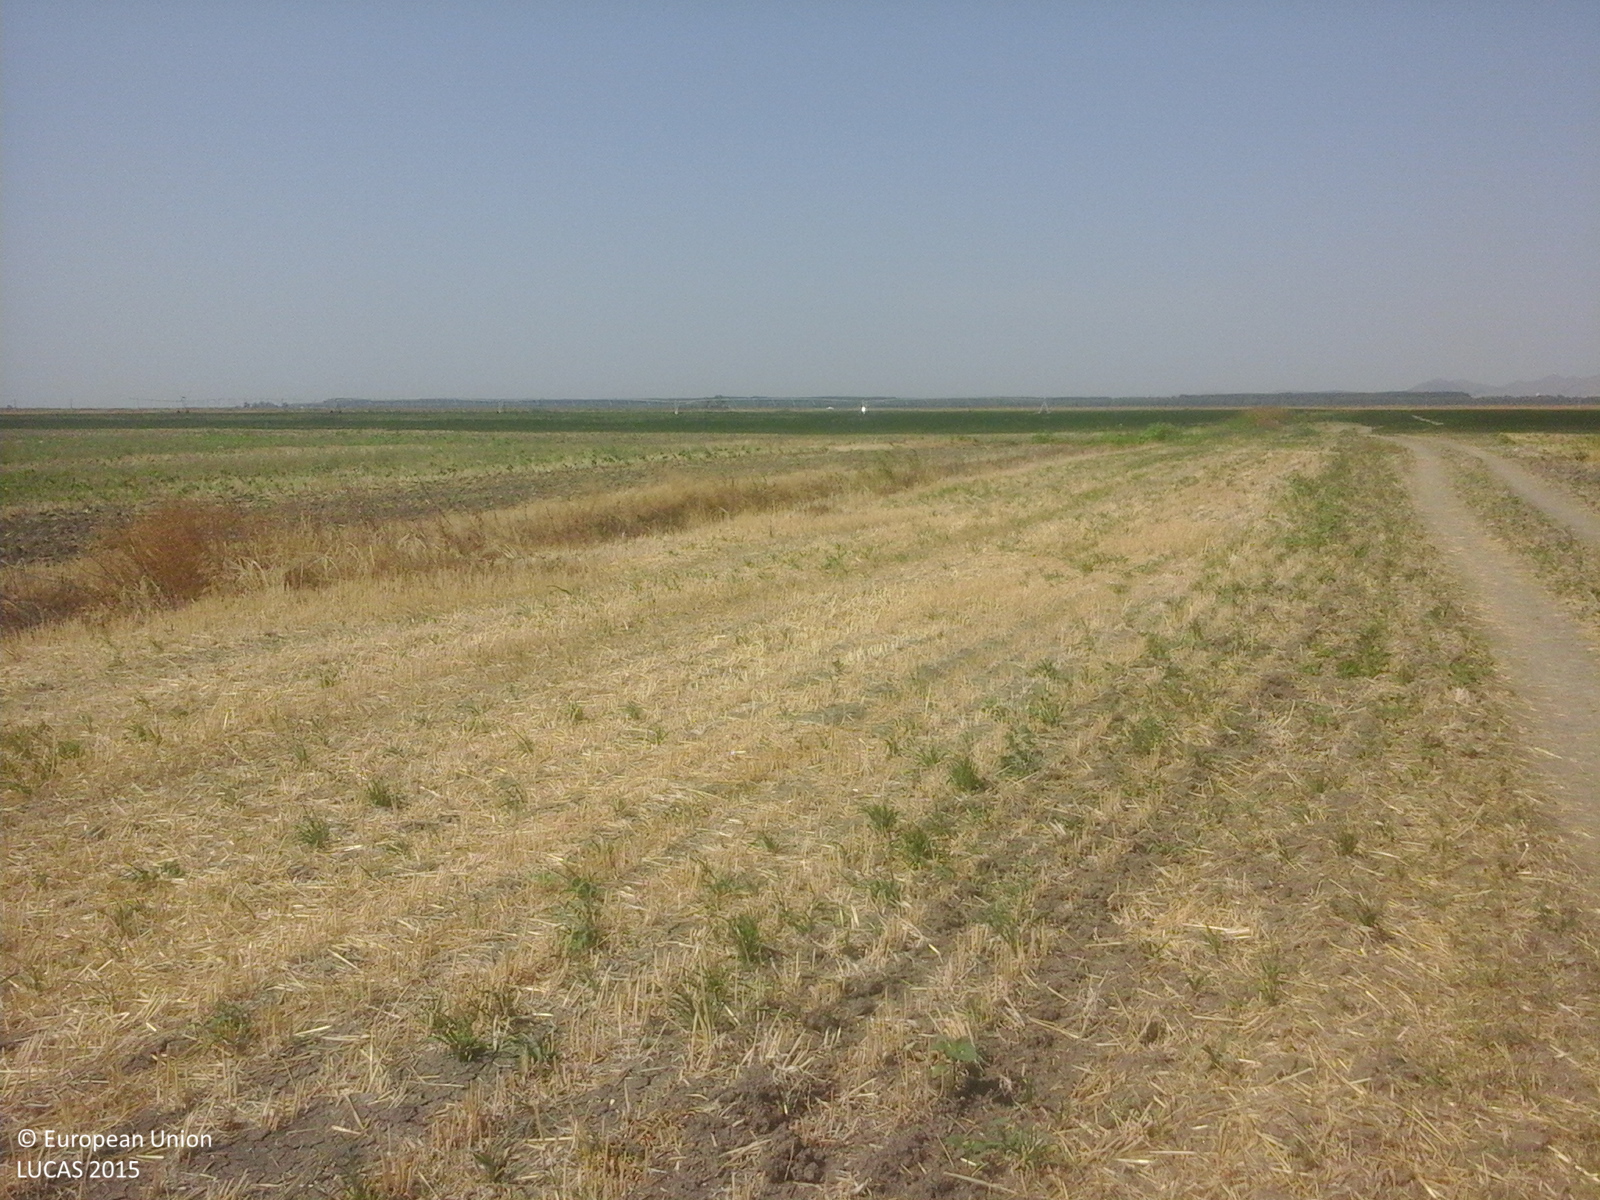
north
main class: Cropland
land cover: Common wheat
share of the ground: 50 - 75 %
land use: Agriculture (excluding fallow land and kitchen gardens)
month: August
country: RO
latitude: 45.1386
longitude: 28.1116
